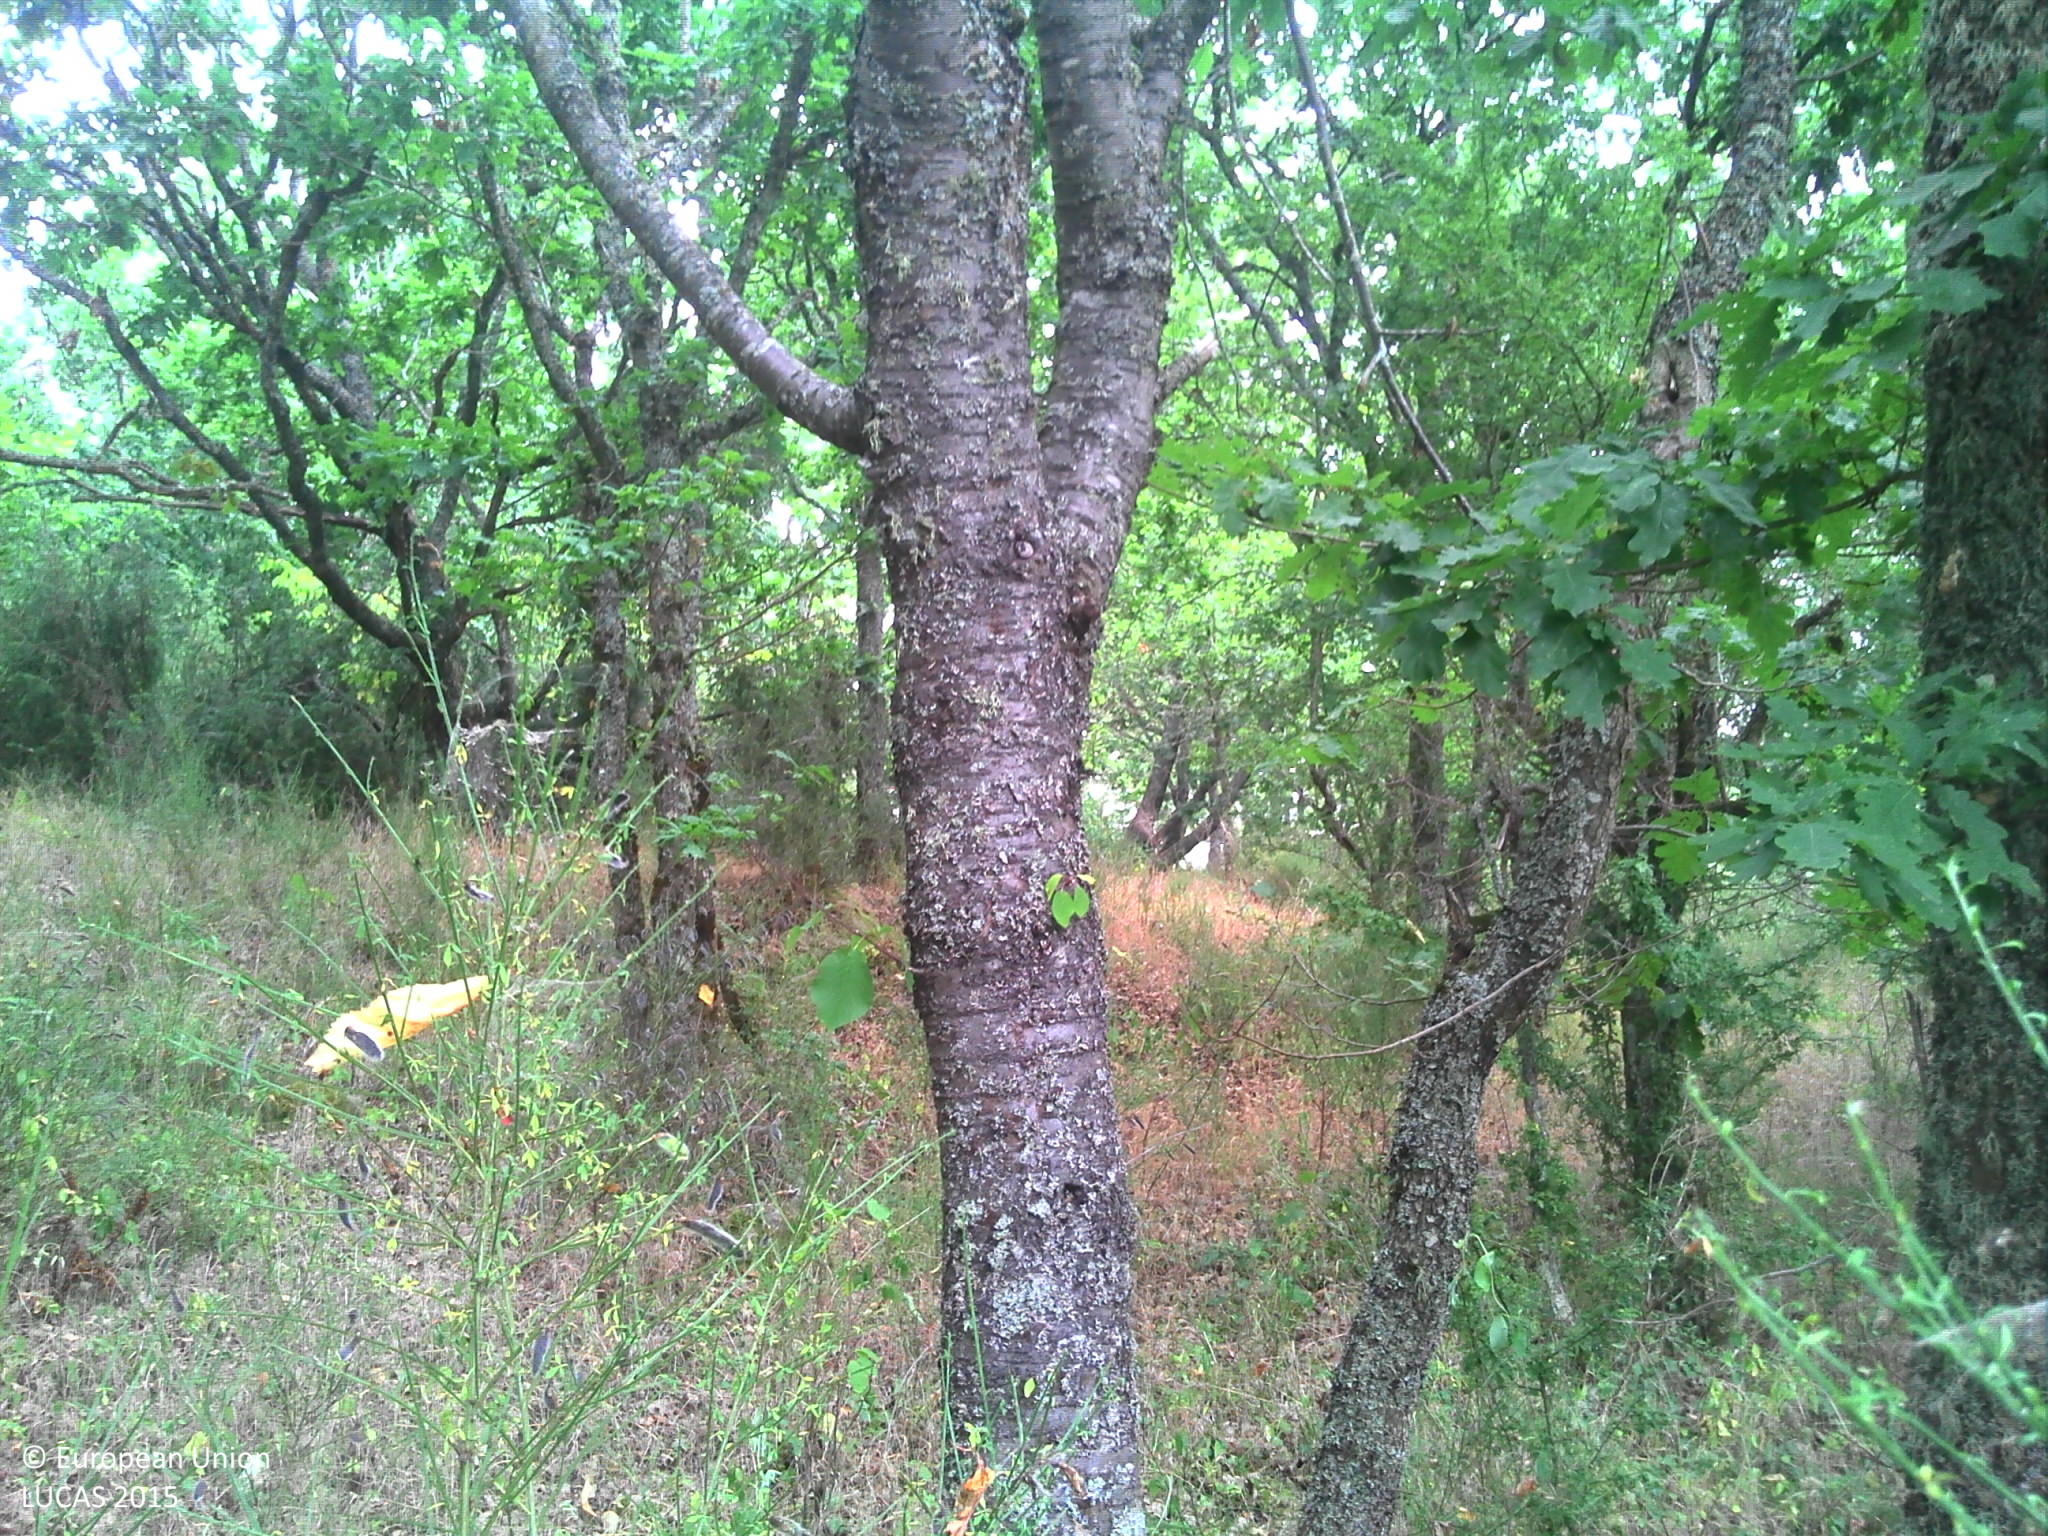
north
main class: Woodland
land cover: Broadleaved woodland
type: acidophilous oak and oak-birch forest
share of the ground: > 75 %
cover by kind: herbaceous plants 40 %, broadleaved forest trees 30 %, shrubs 25 %, lichens and mosses 5 %
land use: Forestry
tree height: > 5 m
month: July
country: FR
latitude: 45.9244
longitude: 3.0229
